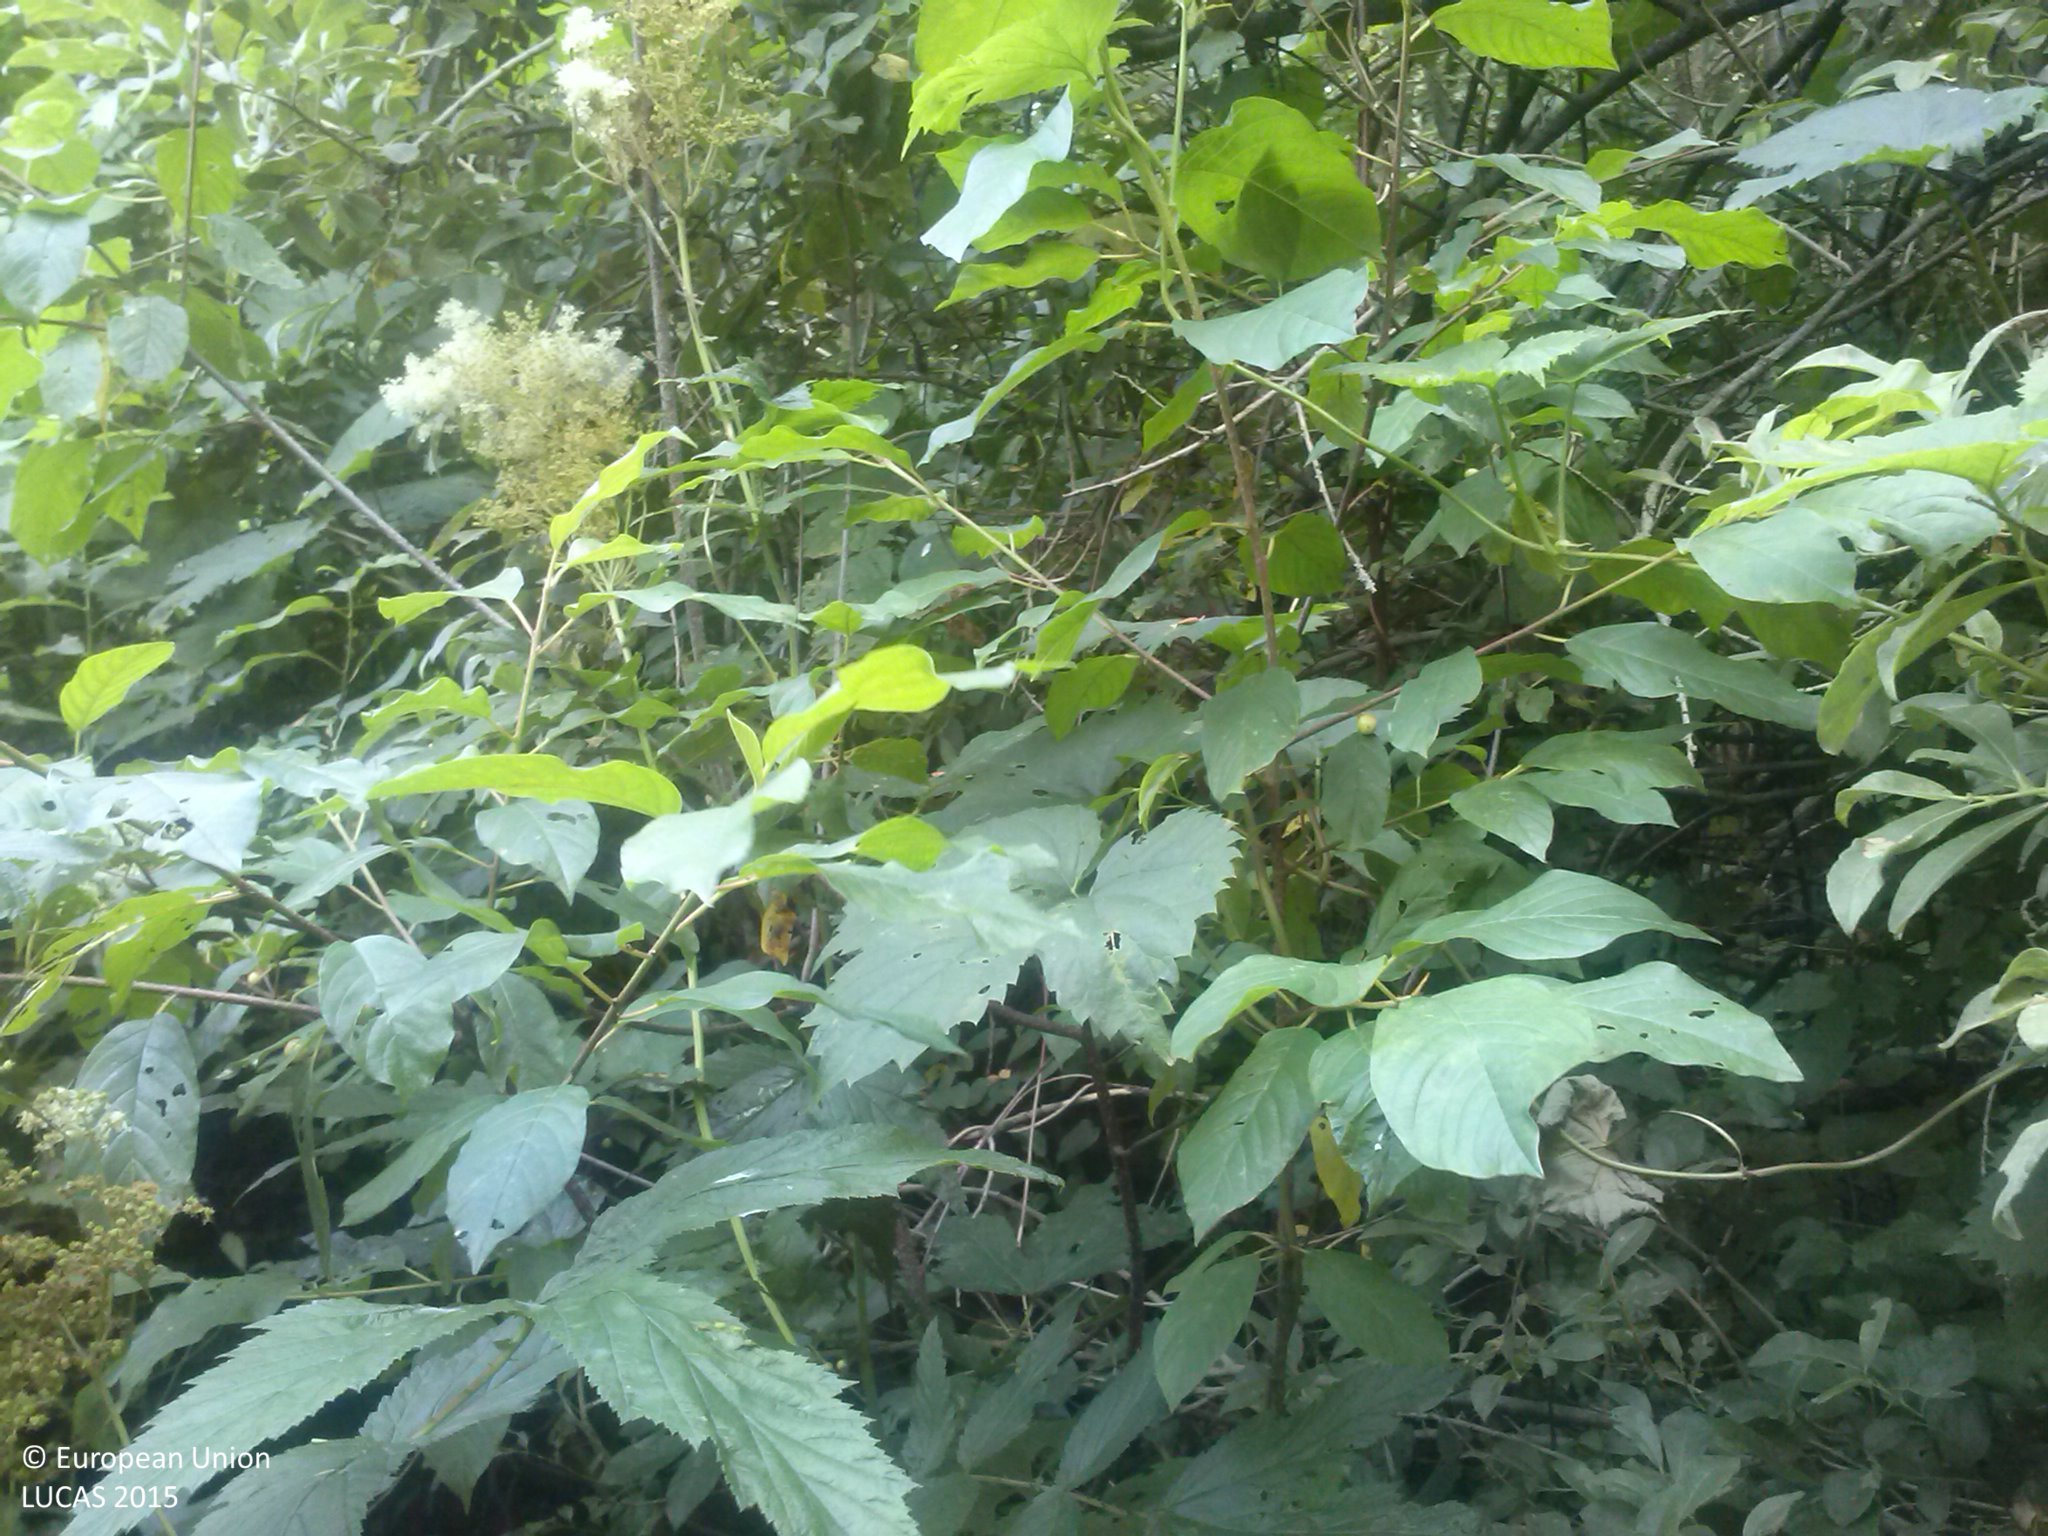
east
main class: Woodland
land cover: Broadleaved woodland
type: non-riverine alder, birch or aspen forest
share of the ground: > 75 %
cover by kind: broadleaved forest trees 90 %, herbaceous plants 10 %
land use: Forestry
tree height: > 5 m
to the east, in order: Broadleaved woodland; Ditches and canals; Broadleaved woodland
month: July
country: LV
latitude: 56.6779
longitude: 27.0234
